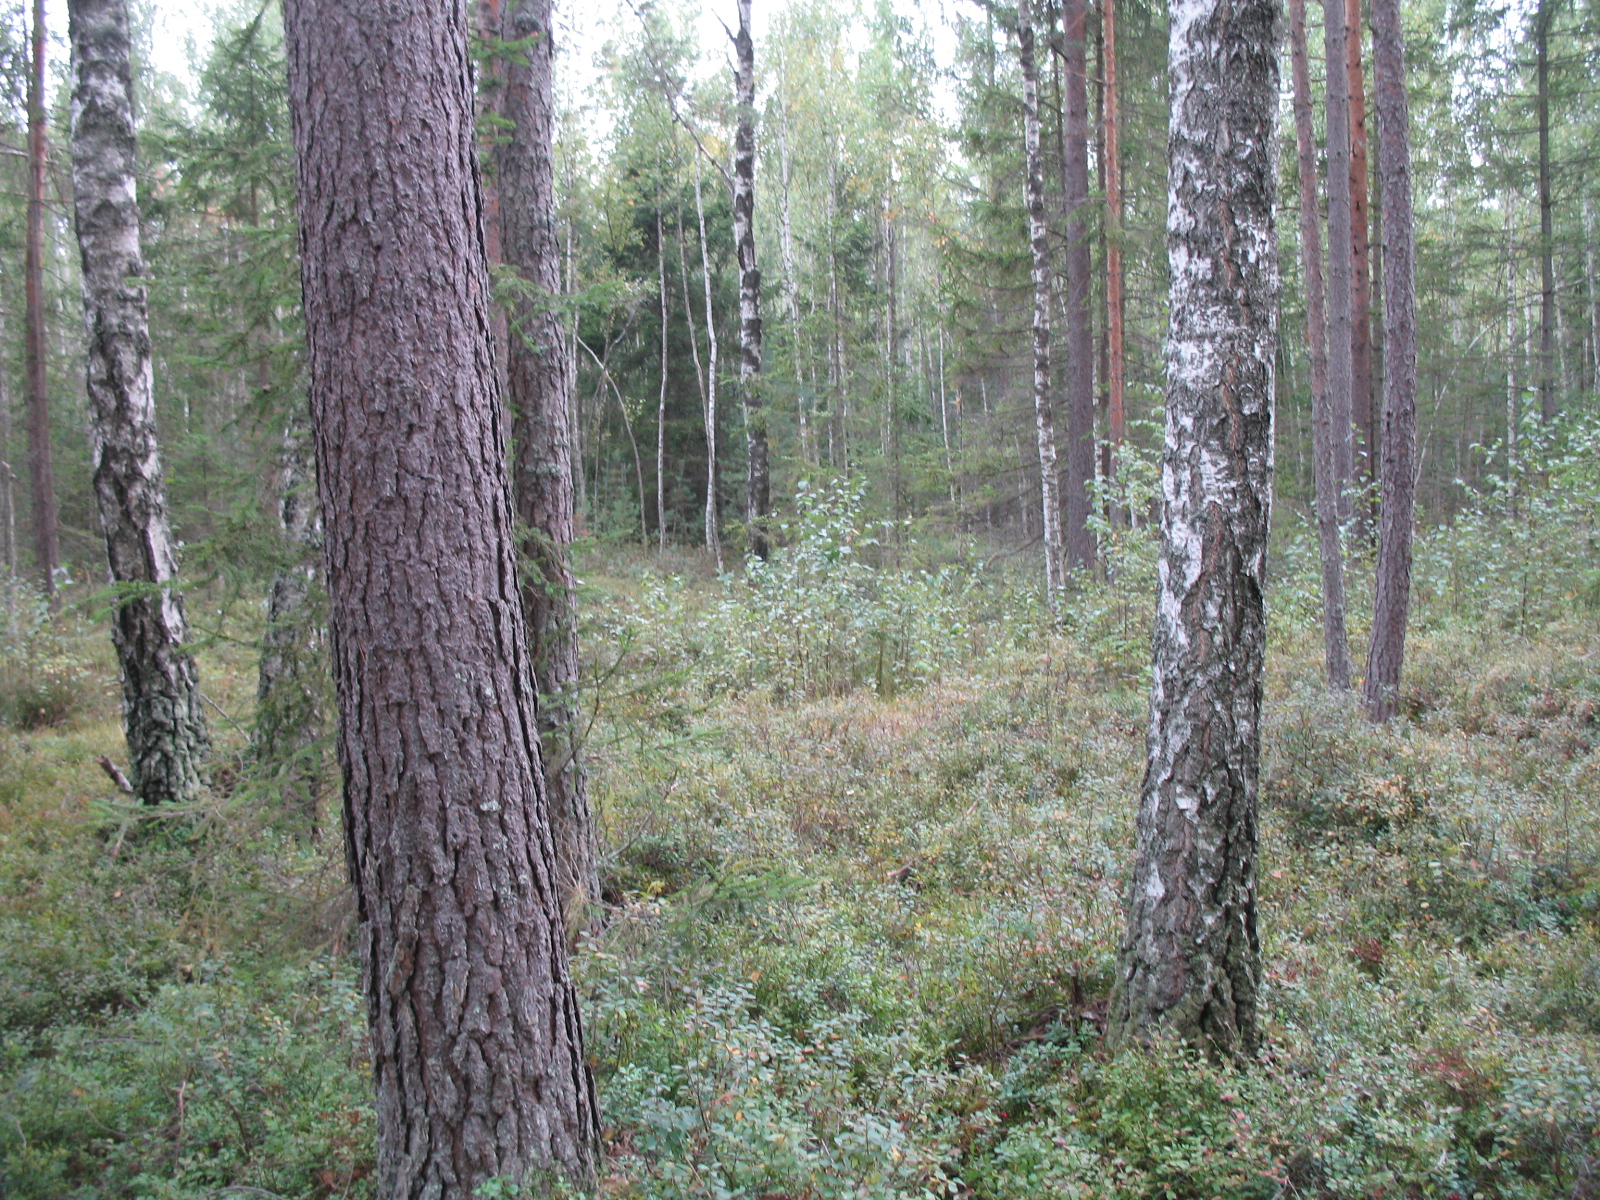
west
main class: Woodland
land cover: Other mixed woodland
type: hemiboreal forest and nemoral coniferous forest and mixed broadleaved-coniferous forest
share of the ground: 25 - 50 %
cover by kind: coniferous forest trees 25 %, herbaceous plants 25 %, lichens and mosses 25 %, broadleaved forest trees 20 %, shrubs 5 %
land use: Forestry
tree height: > 5 m
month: September
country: LV
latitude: 56.1531
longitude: 25.9589
